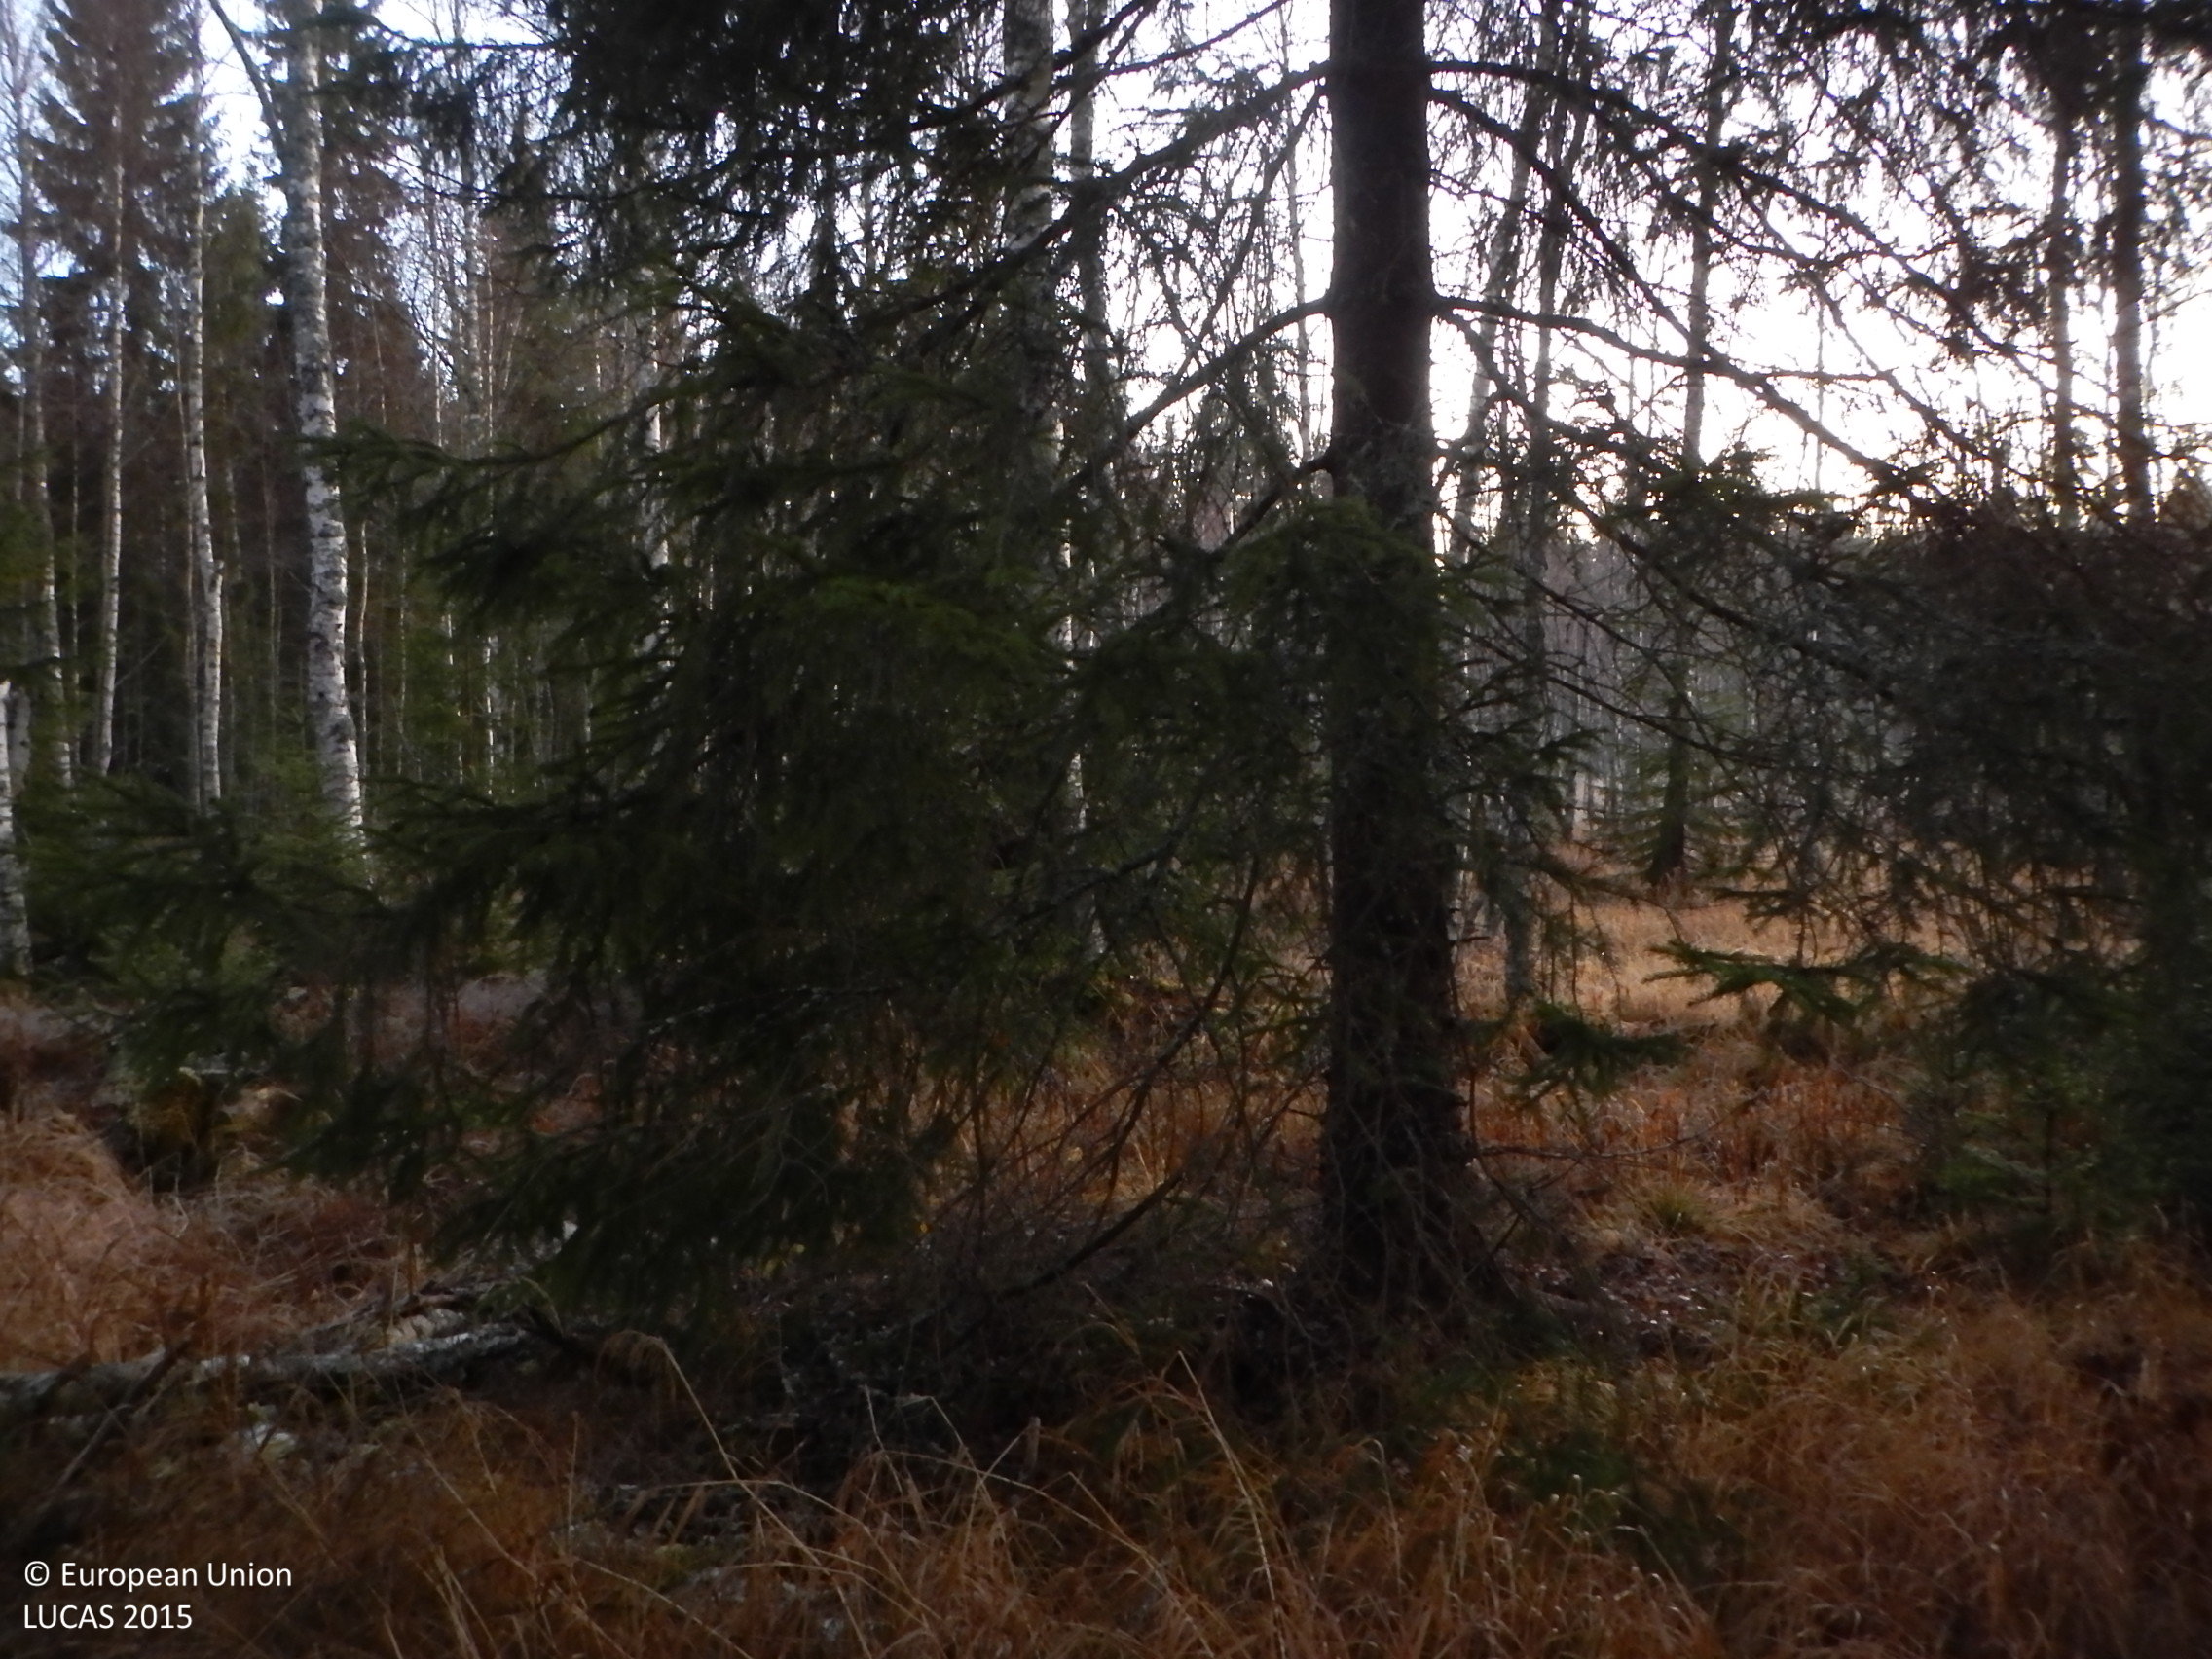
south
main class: Woodland
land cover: Spruce dominated mixed woodland
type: boreal forest
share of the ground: 50 - 75 %
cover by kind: coniferous forest trees 30 %, broadleaved forest trees 30 %, herbaceous plants 30 %, shrubs 10 %
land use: Forestry
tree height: > 5 m
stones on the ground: < 10 %
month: November
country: SE
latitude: 61.4035
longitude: 16.1086
